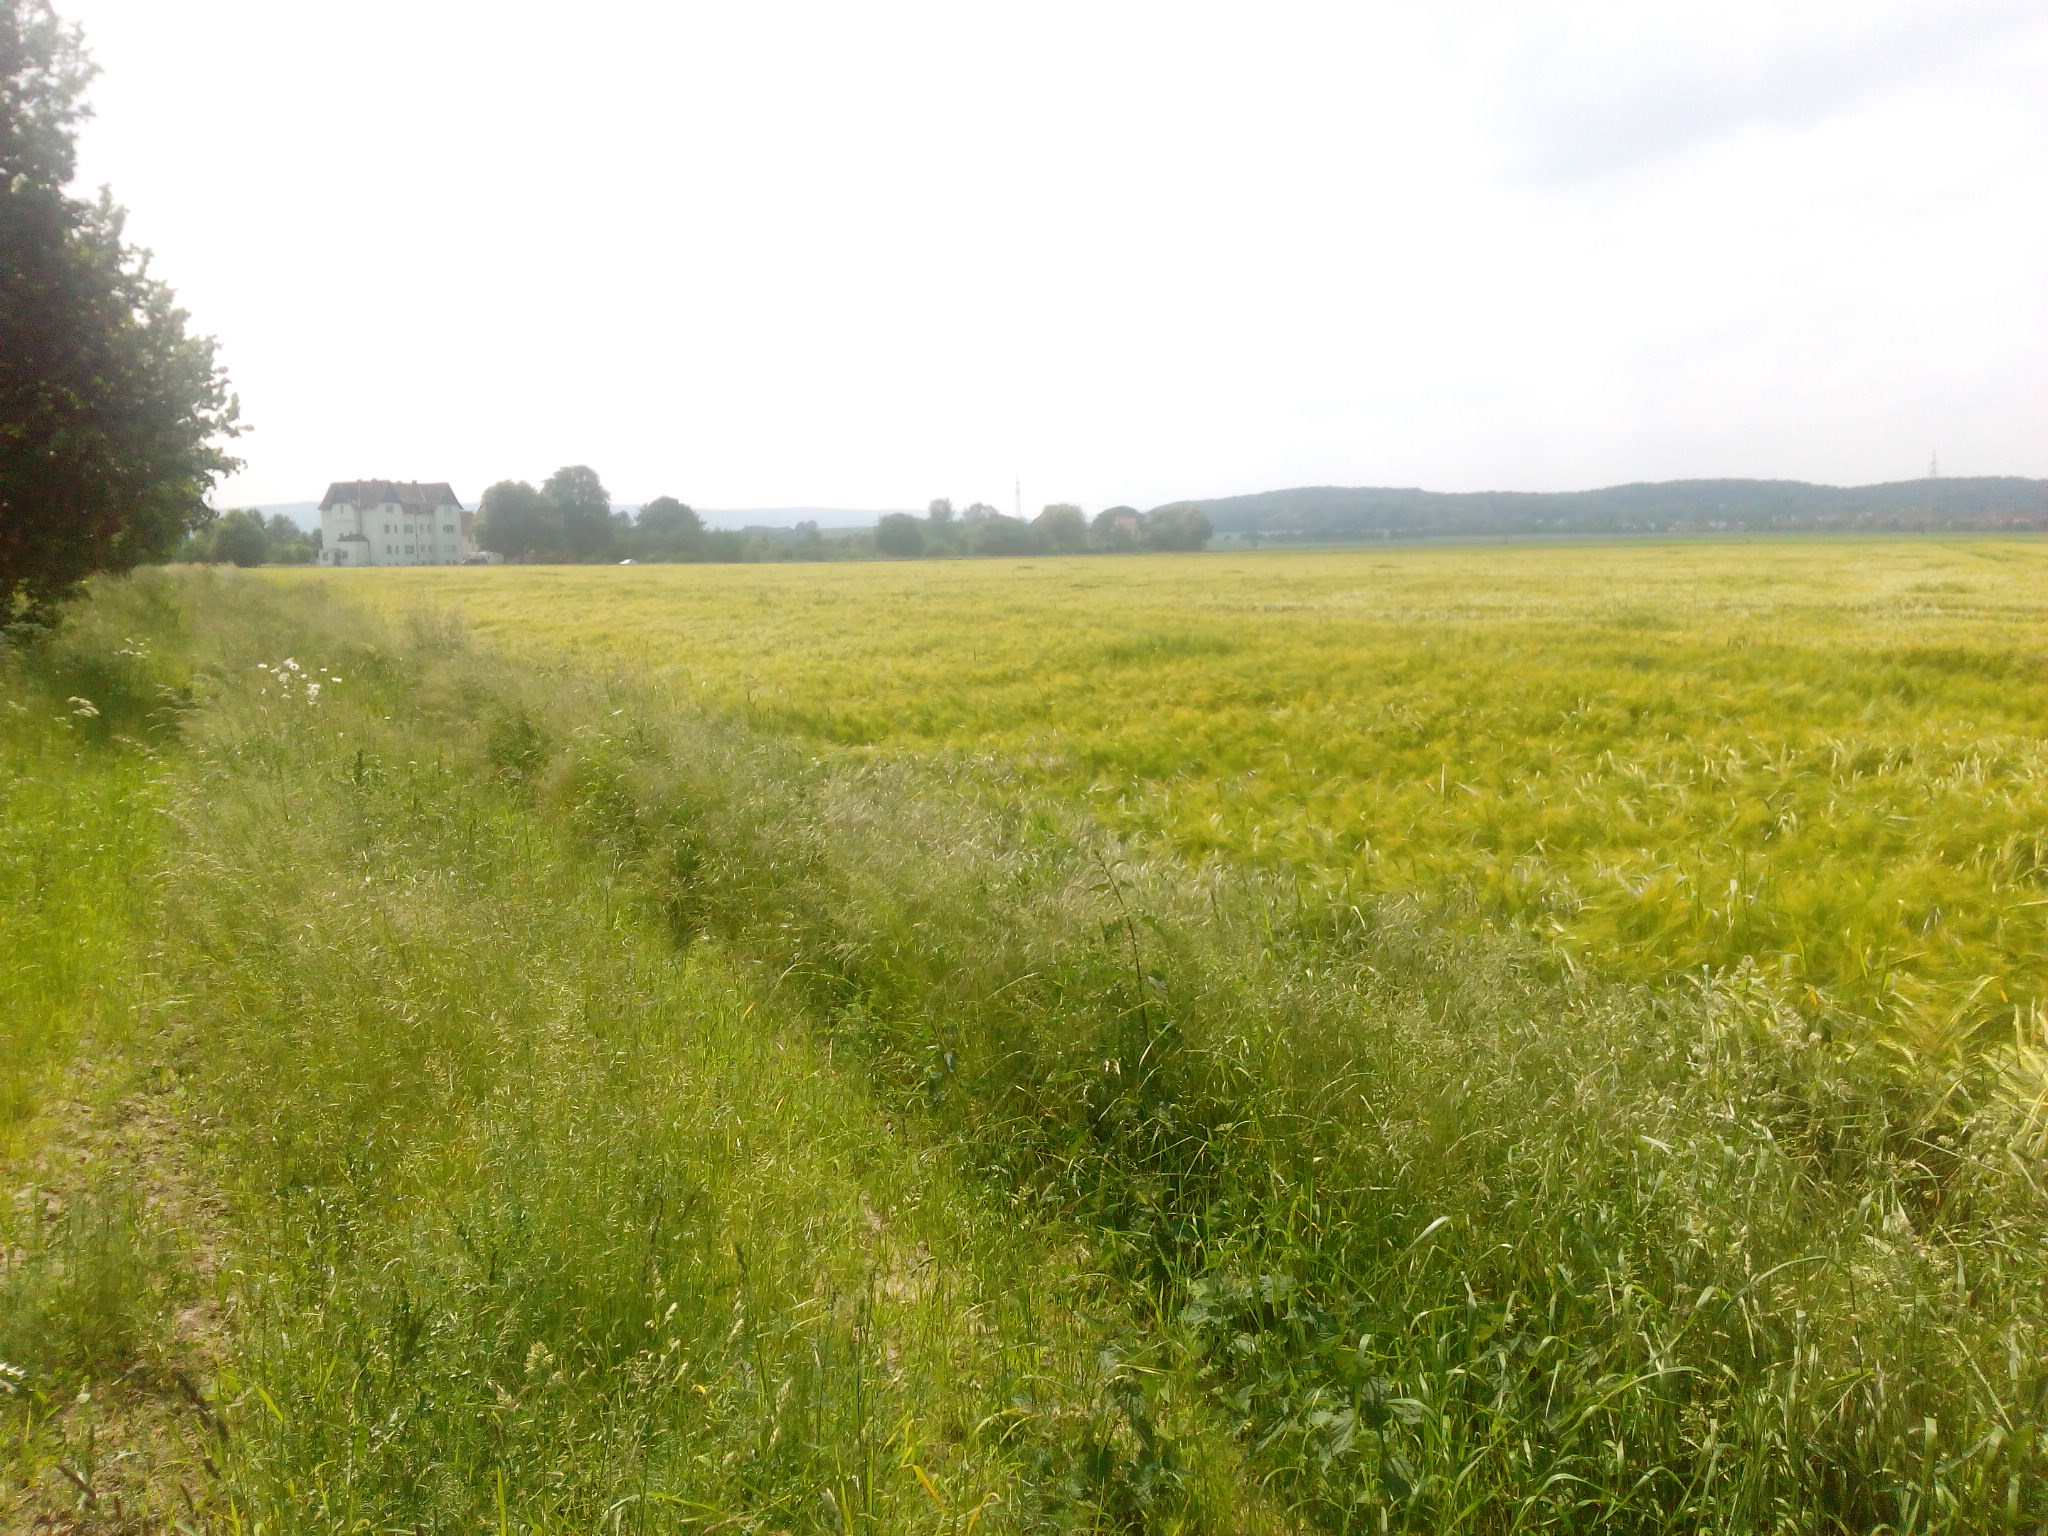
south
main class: Cropland
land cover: Barley
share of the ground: > 75 %
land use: Agriculture (excluding fallow land and kitchen gardens)
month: June
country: DE
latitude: 52.3050
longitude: 9.6335
